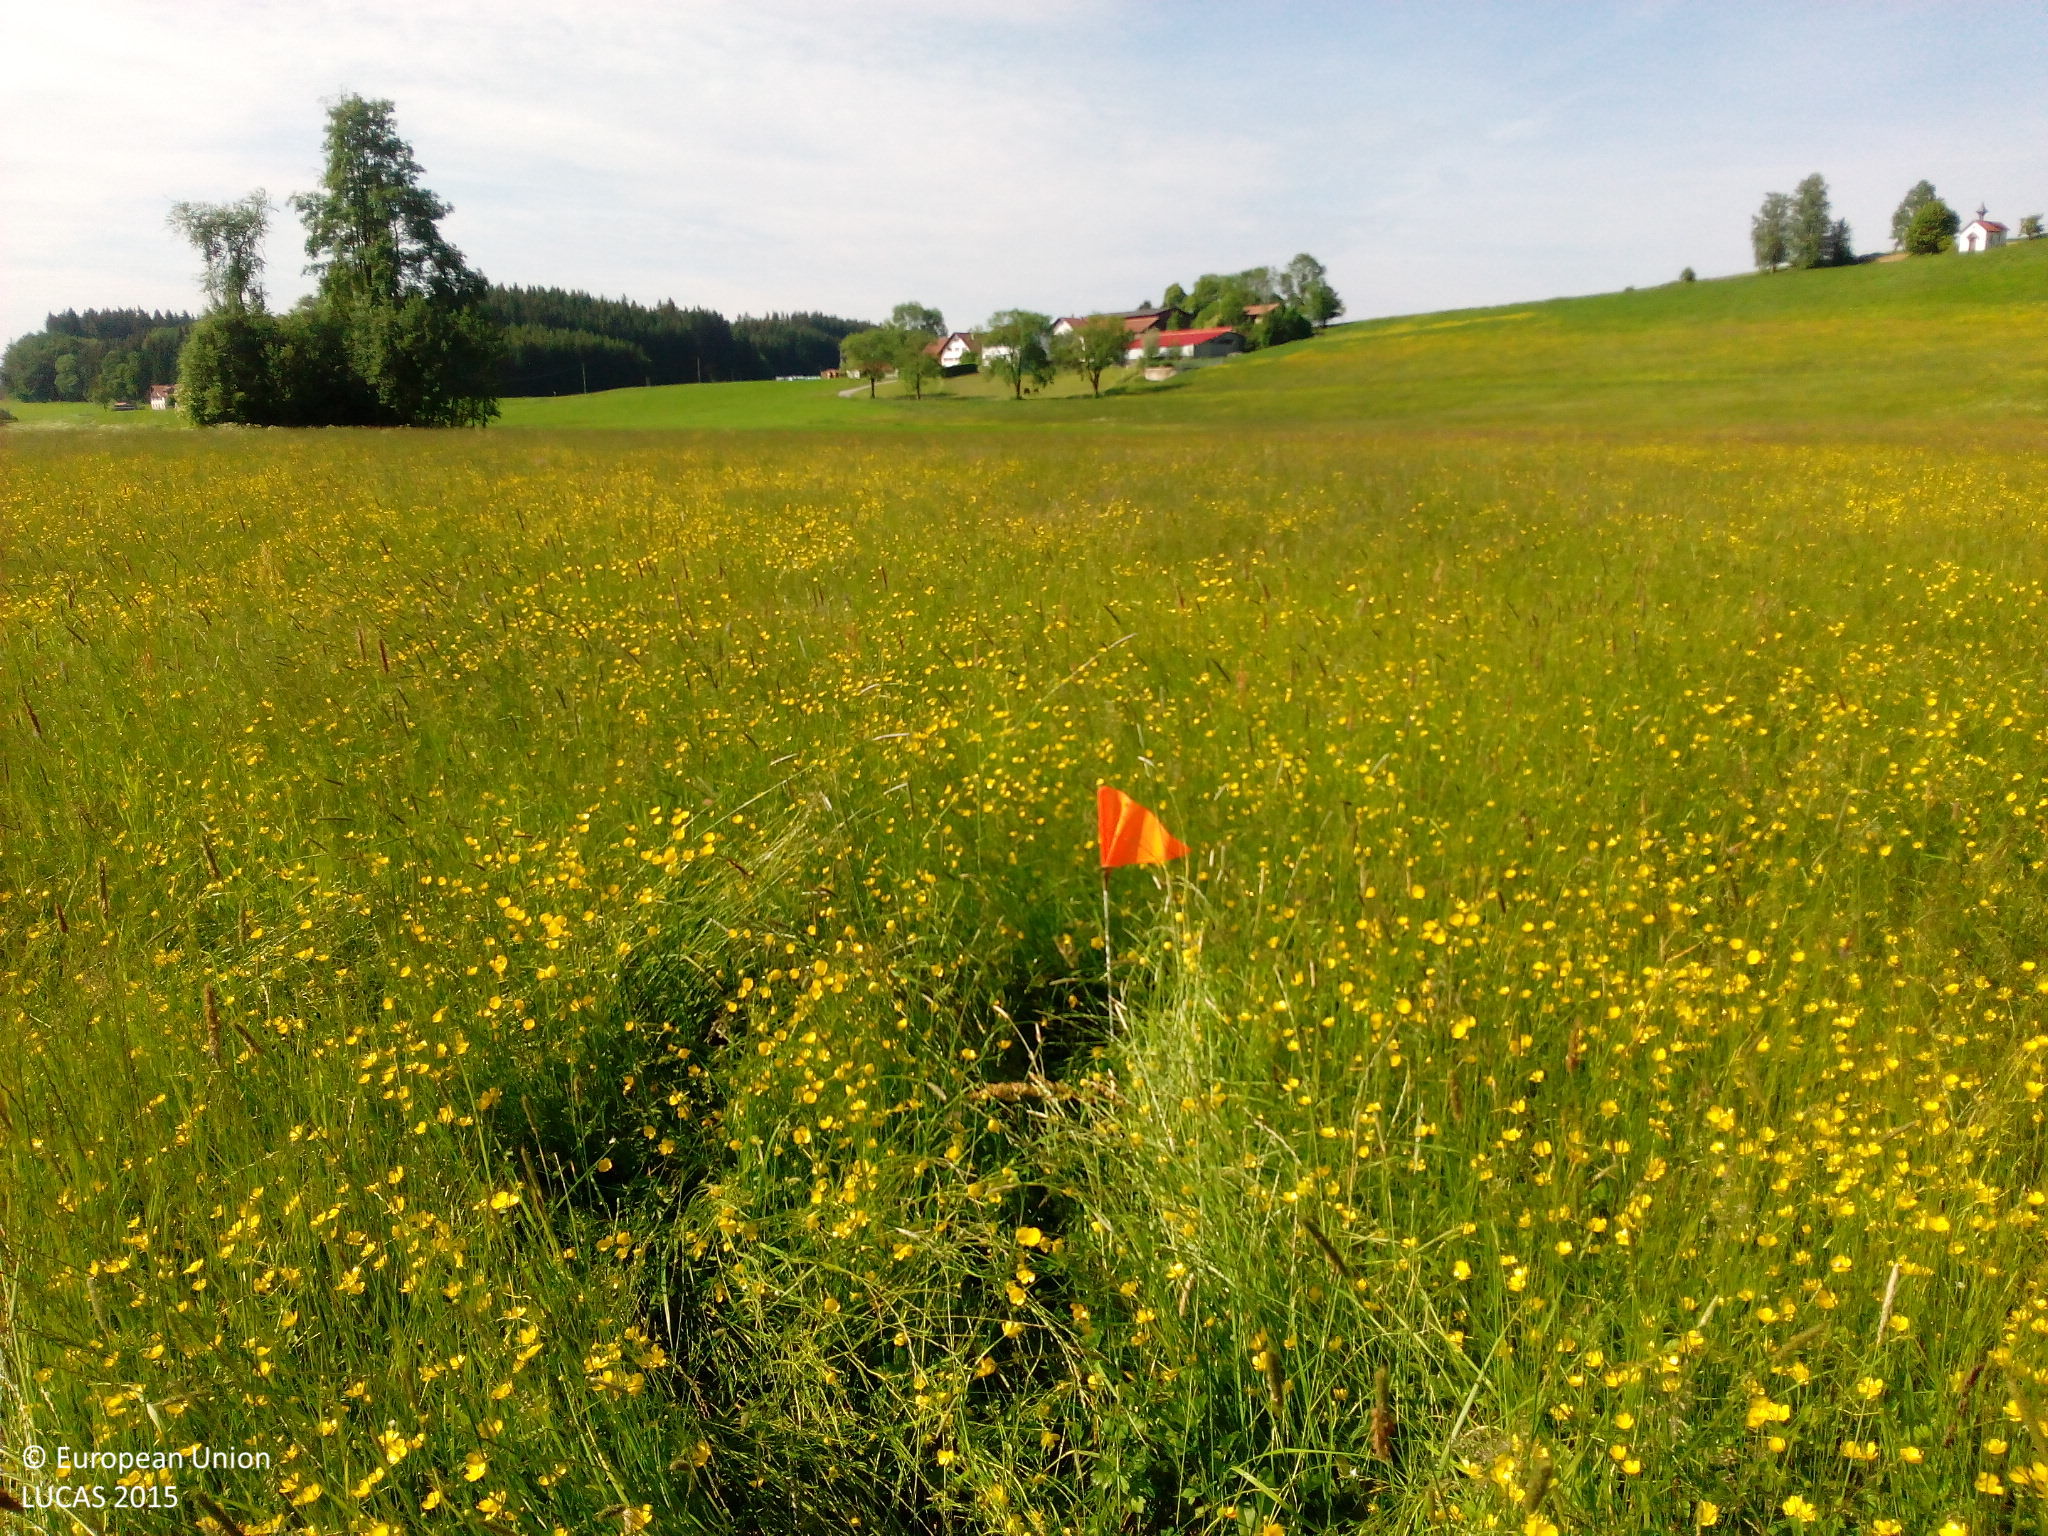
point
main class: Grassland
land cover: Grassland without tree/shrub cover
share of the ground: > 75 %
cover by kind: herbaceous plants 100 %
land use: Agriculture (excluding fallow land and kitchen gardens)
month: June
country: DE
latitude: 47.8453
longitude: 10.2537
